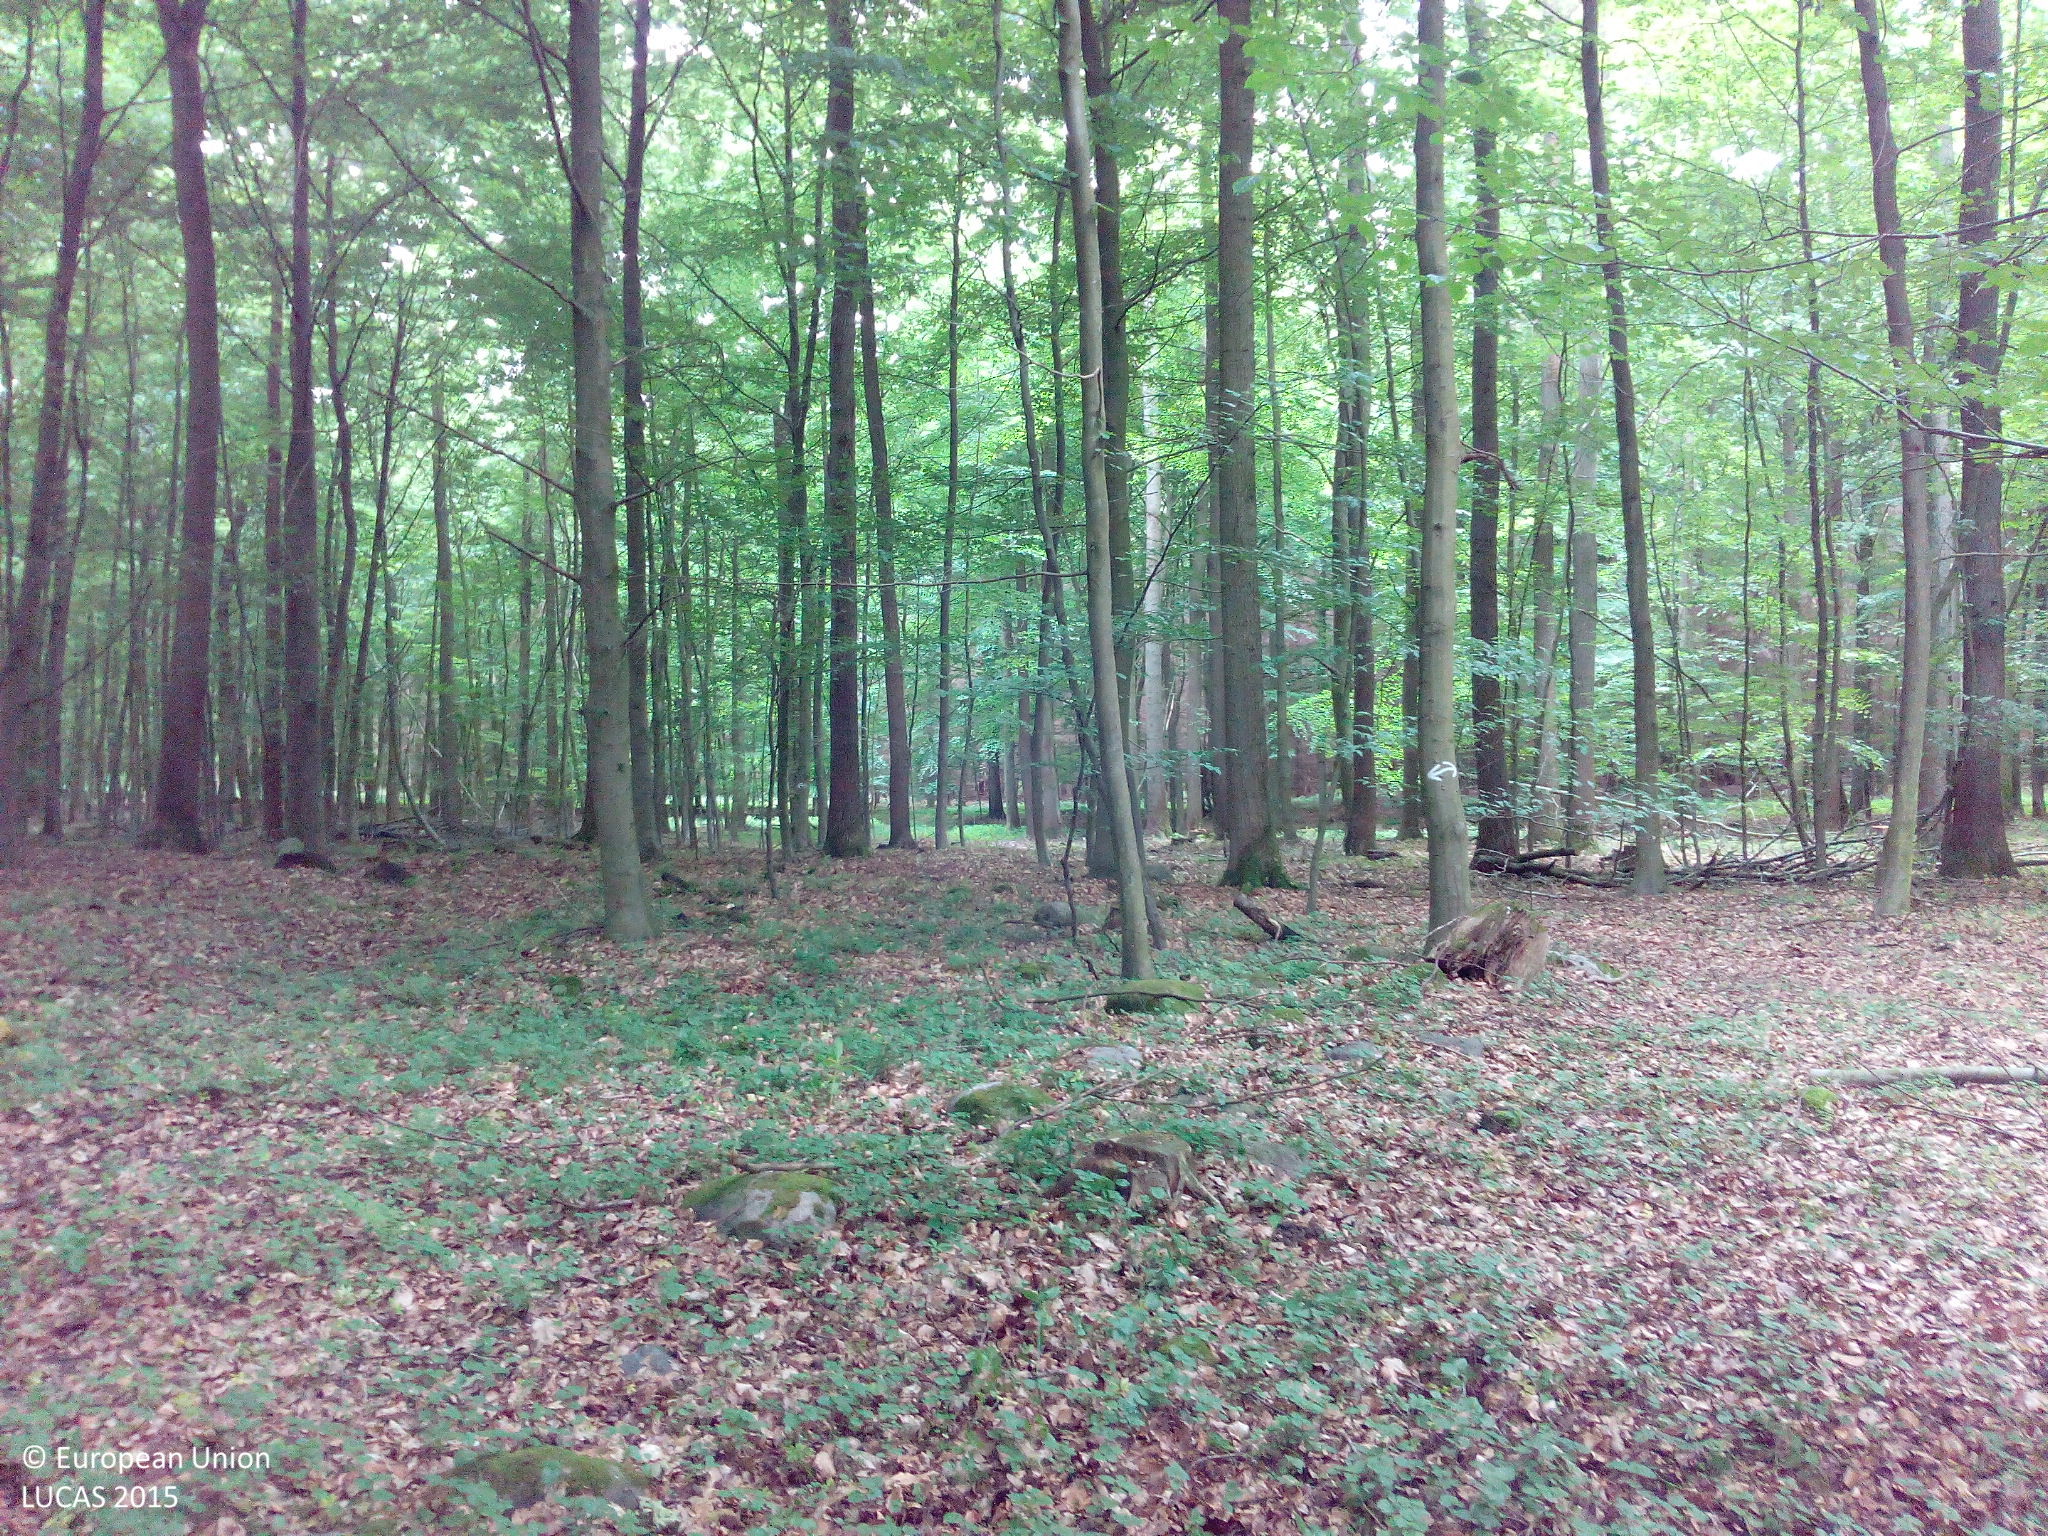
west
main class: Woodland
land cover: Broadleaved woodland
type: beech forest
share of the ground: > 75 %
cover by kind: broadleaved forest trees 85 %, unconsolidated bare surface 10 %, herbaceous plants 5 %
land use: Forestry
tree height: > 5 m
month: June
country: DE
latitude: 53.6306
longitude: 11.1034
